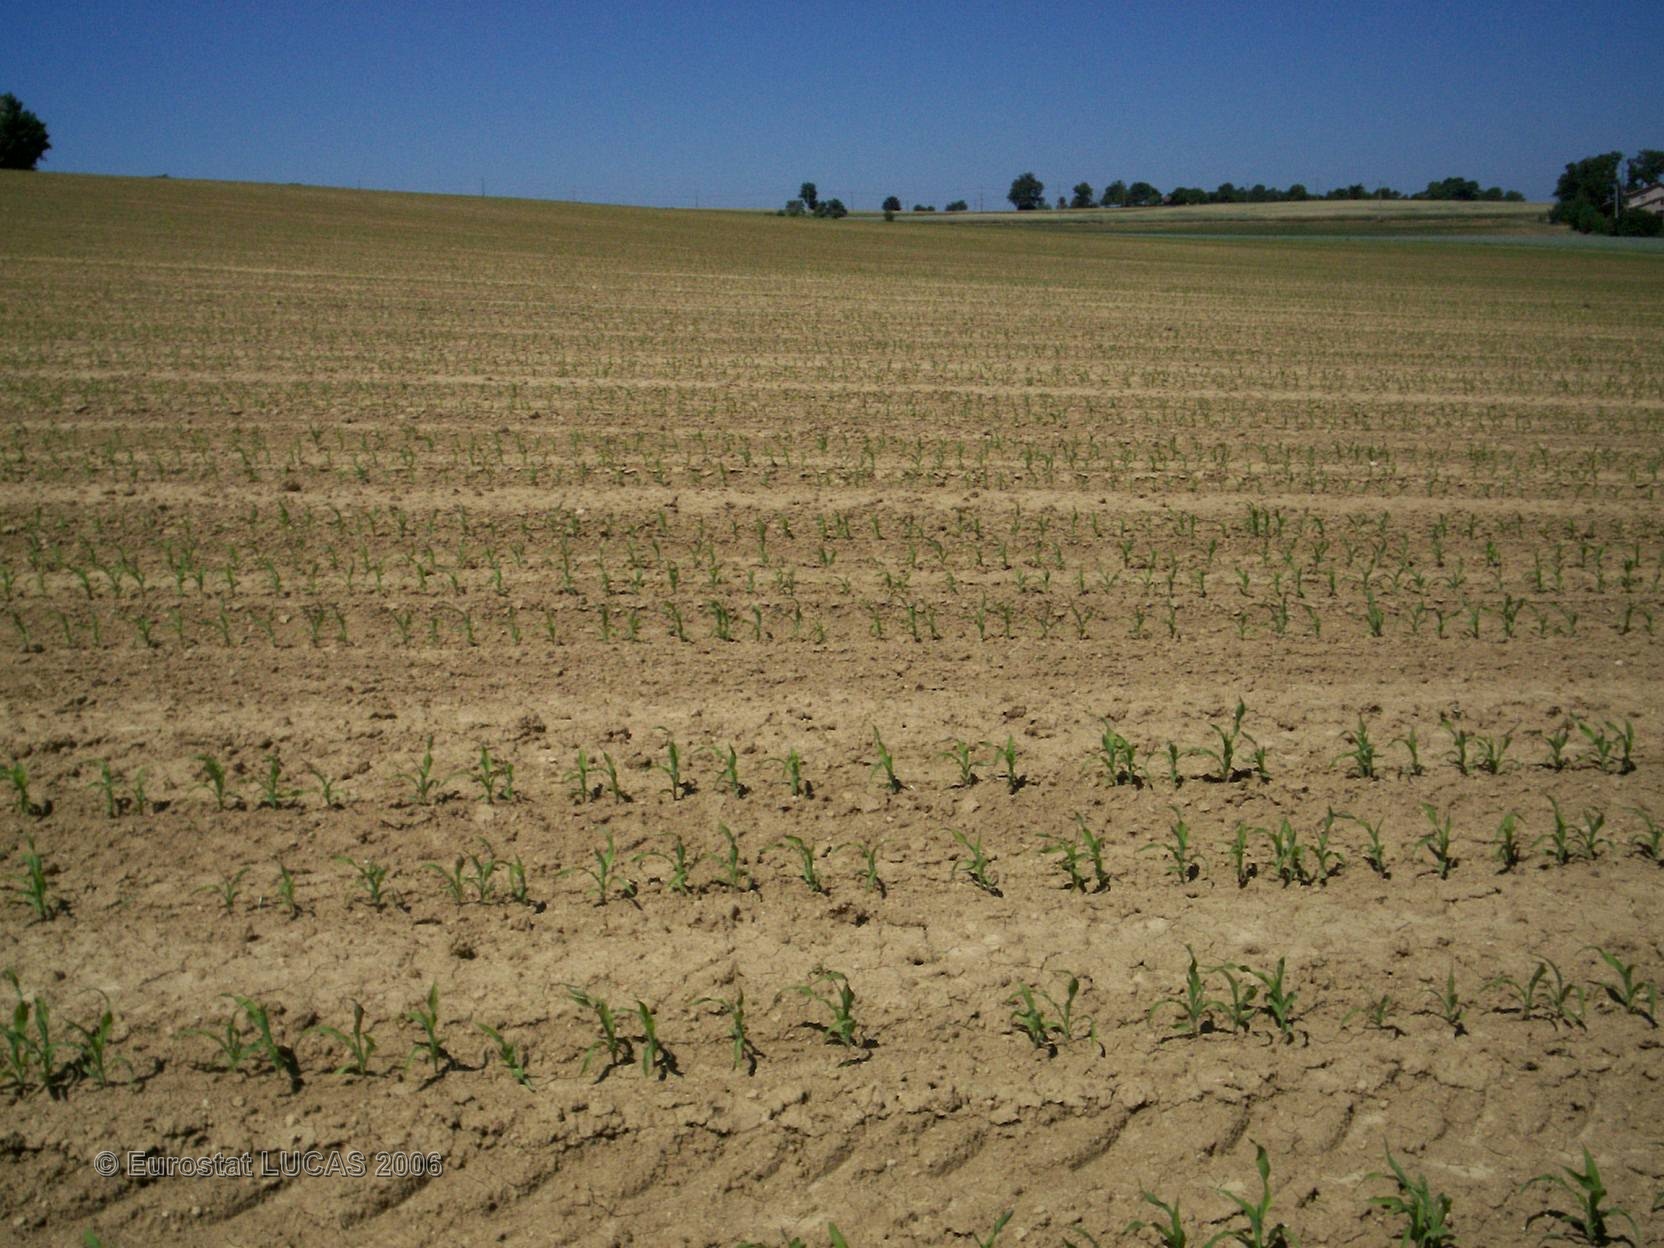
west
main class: Cropland
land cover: Maize
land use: Agriculture (excluding fallow land and kitchen gardens)
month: June
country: FR
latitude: 43.7457
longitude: 0.8466
